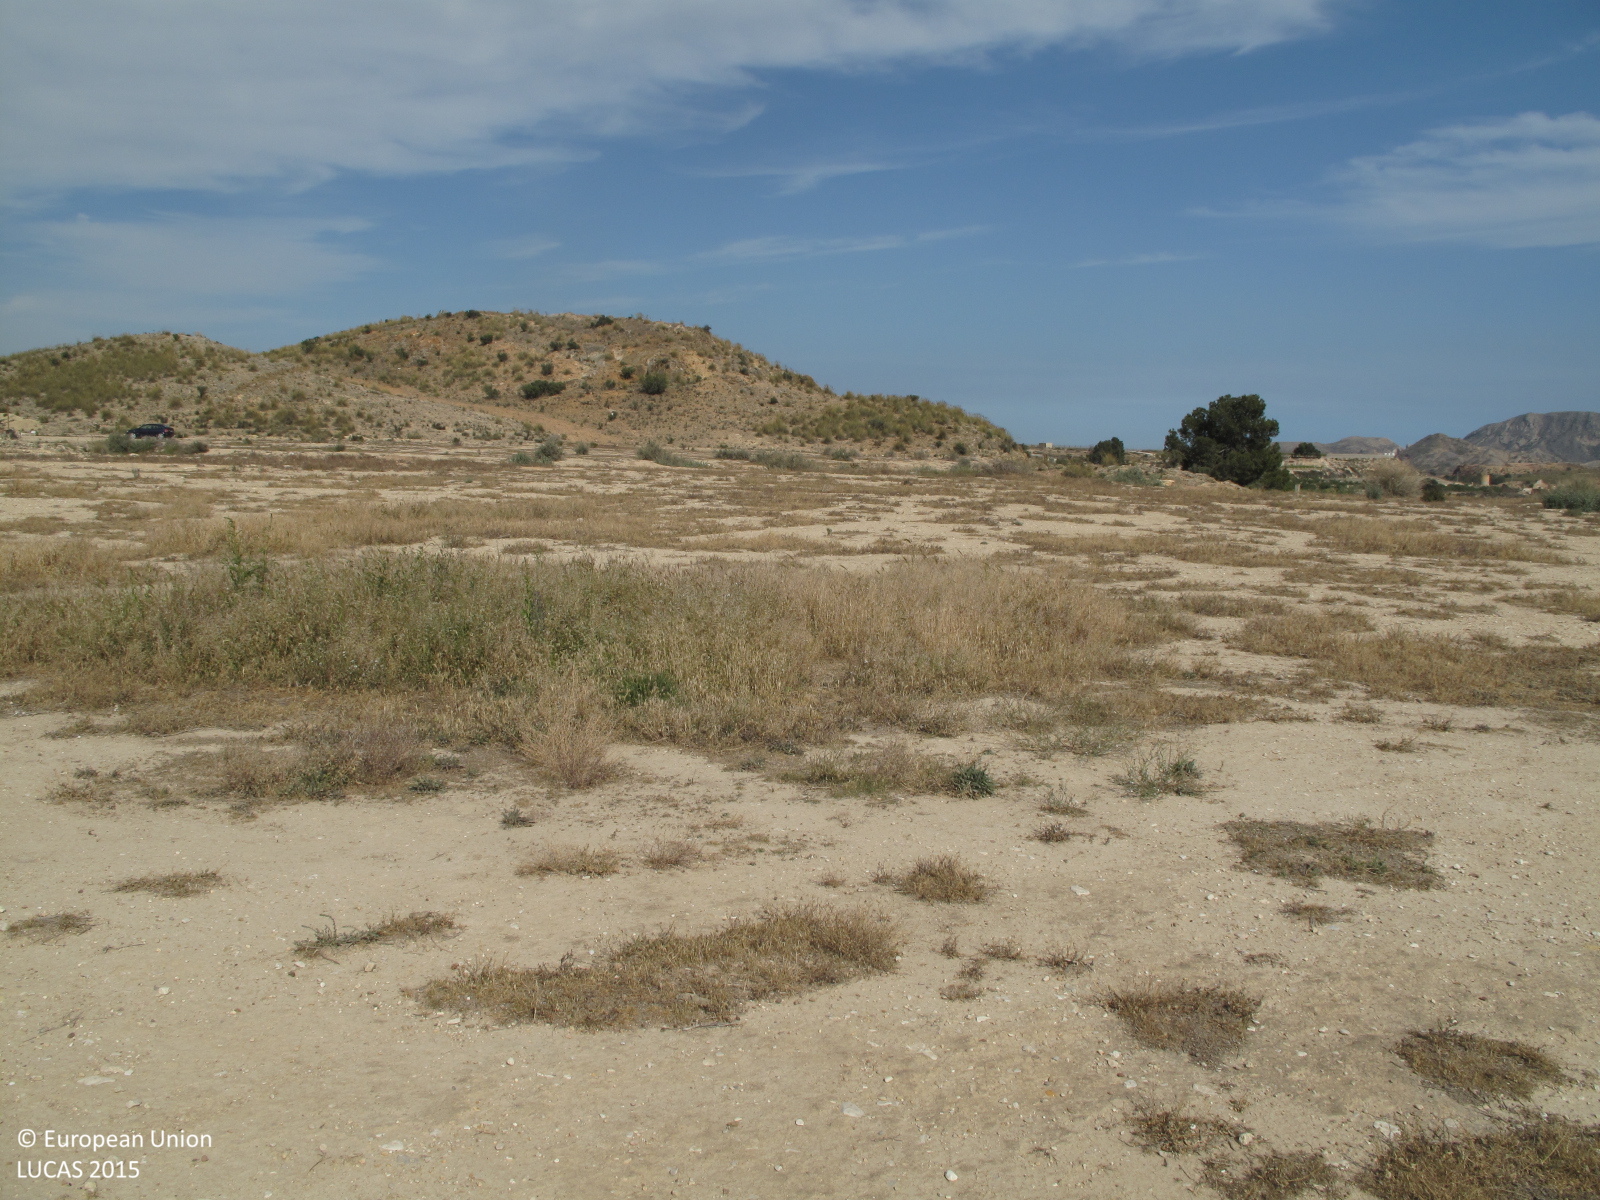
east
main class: Grassland
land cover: Grassland without tree/shrub cover
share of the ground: 10 - 25 %
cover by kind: consolidated bare surface 80 %, herbaceous plants 20 %
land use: Semi-natural and natural areas not in use
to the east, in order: Grassland without tree/shrub cover; Shrubland without tree cover
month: April
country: ES
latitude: 38.4087
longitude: -0.6485
